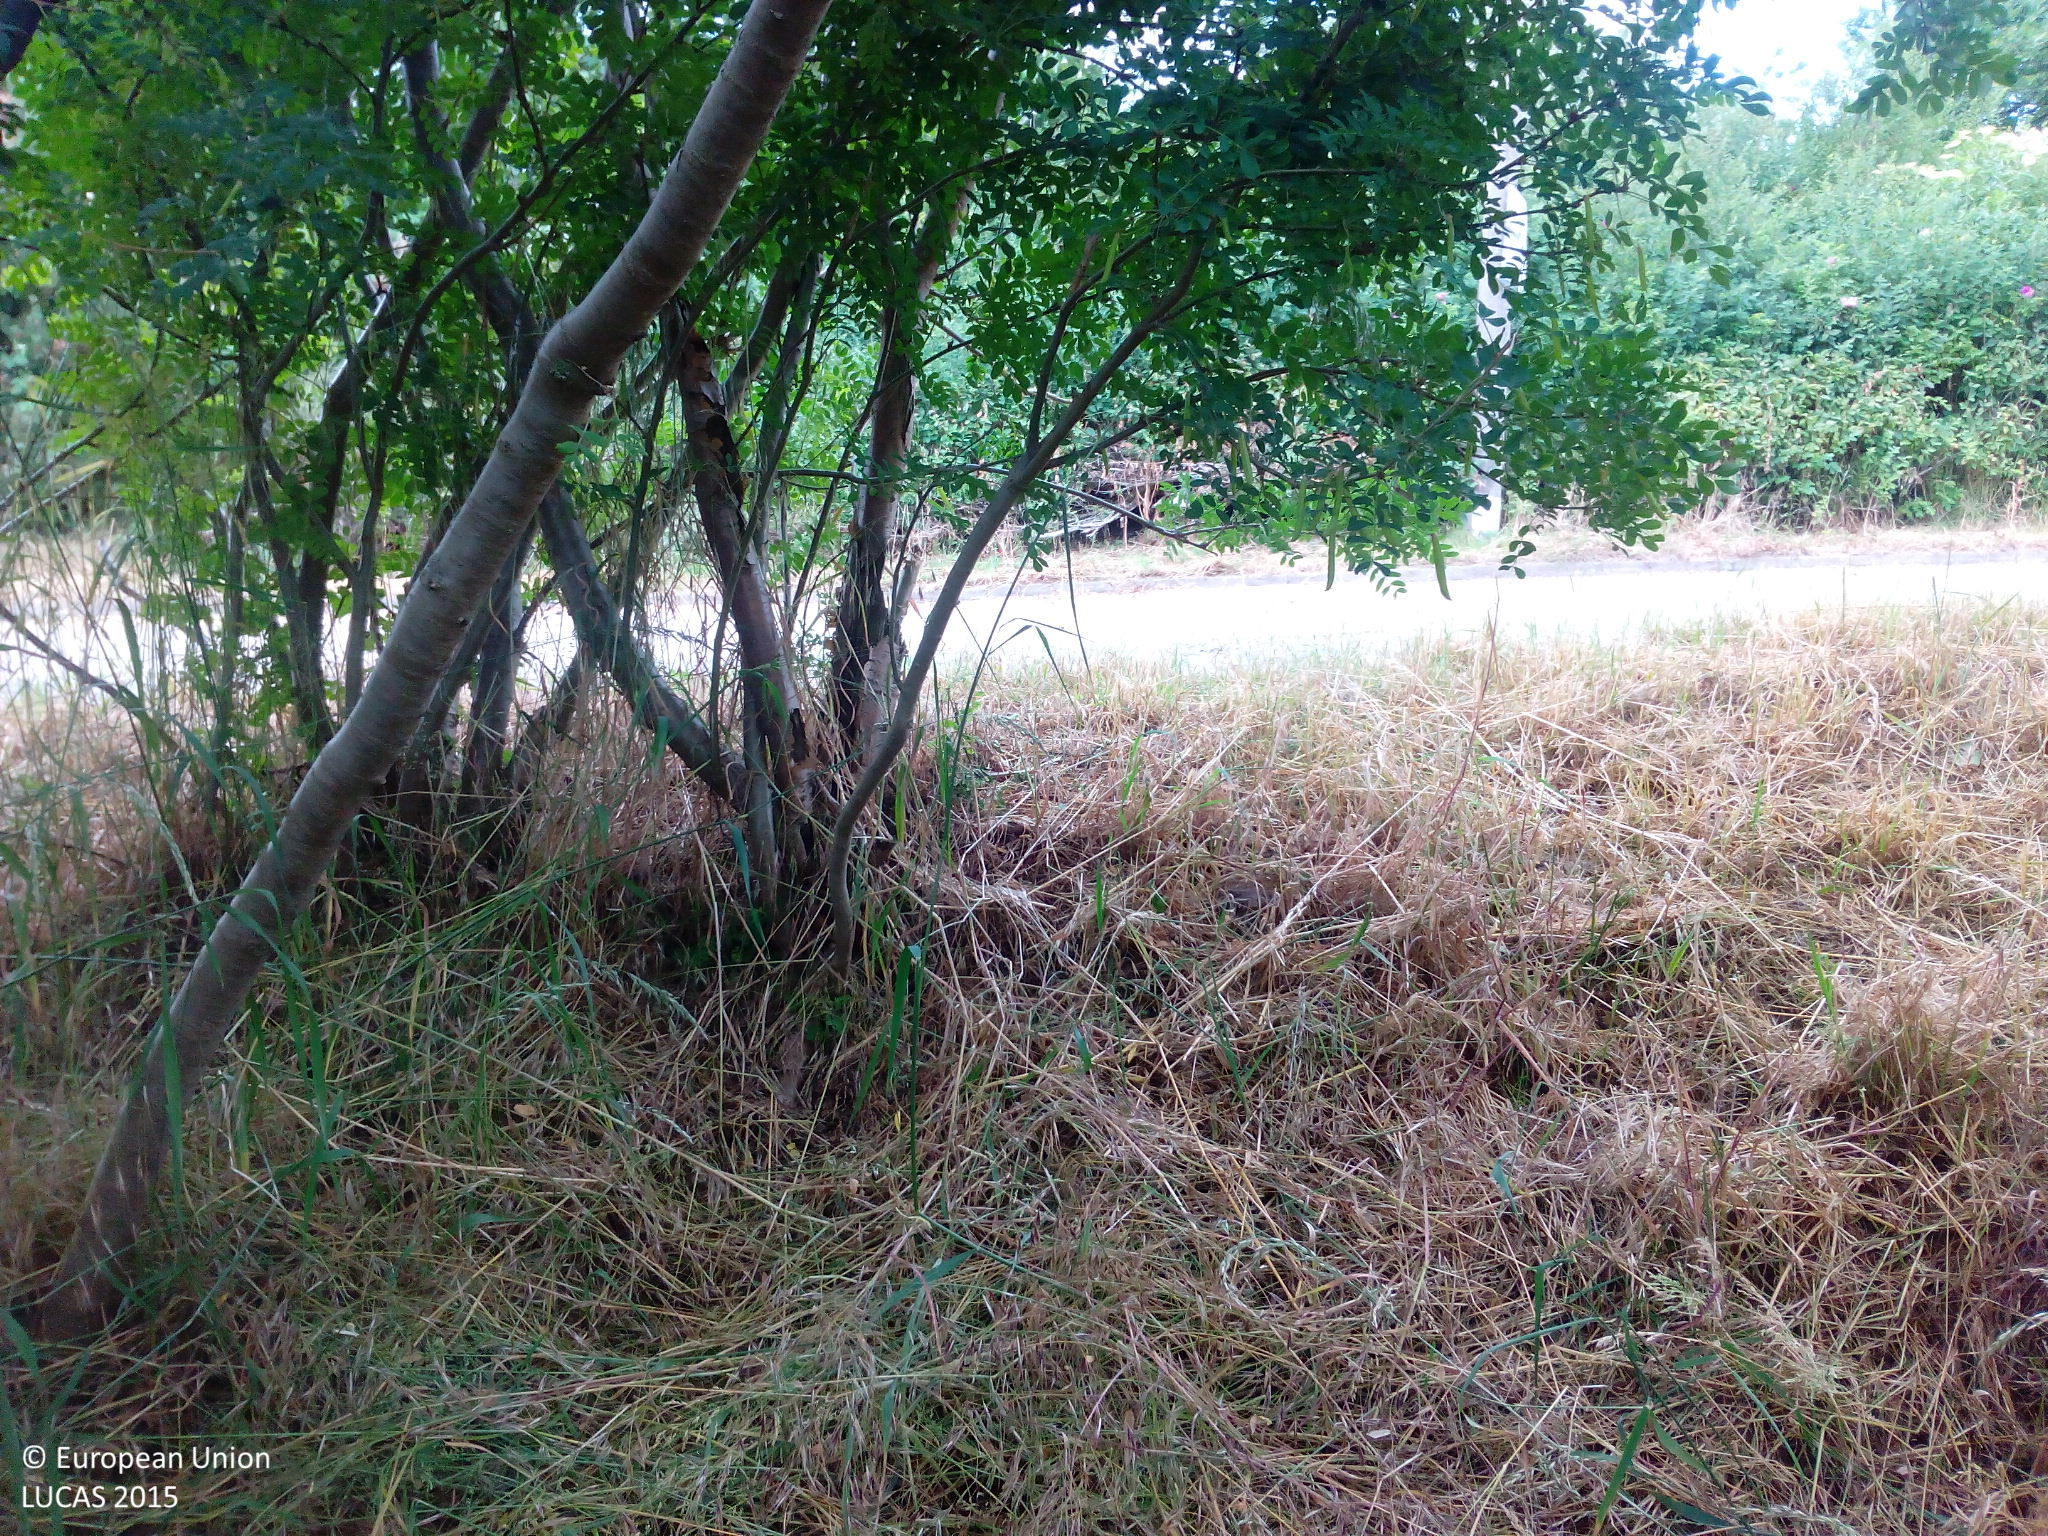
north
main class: Woodland
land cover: Broadleaved woodland
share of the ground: > 75 %
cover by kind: broadleaved forest trees 75 %, herbaceous plants 25 %
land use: Other primary production
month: June
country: DE
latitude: 53.8636
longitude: 11.1702
